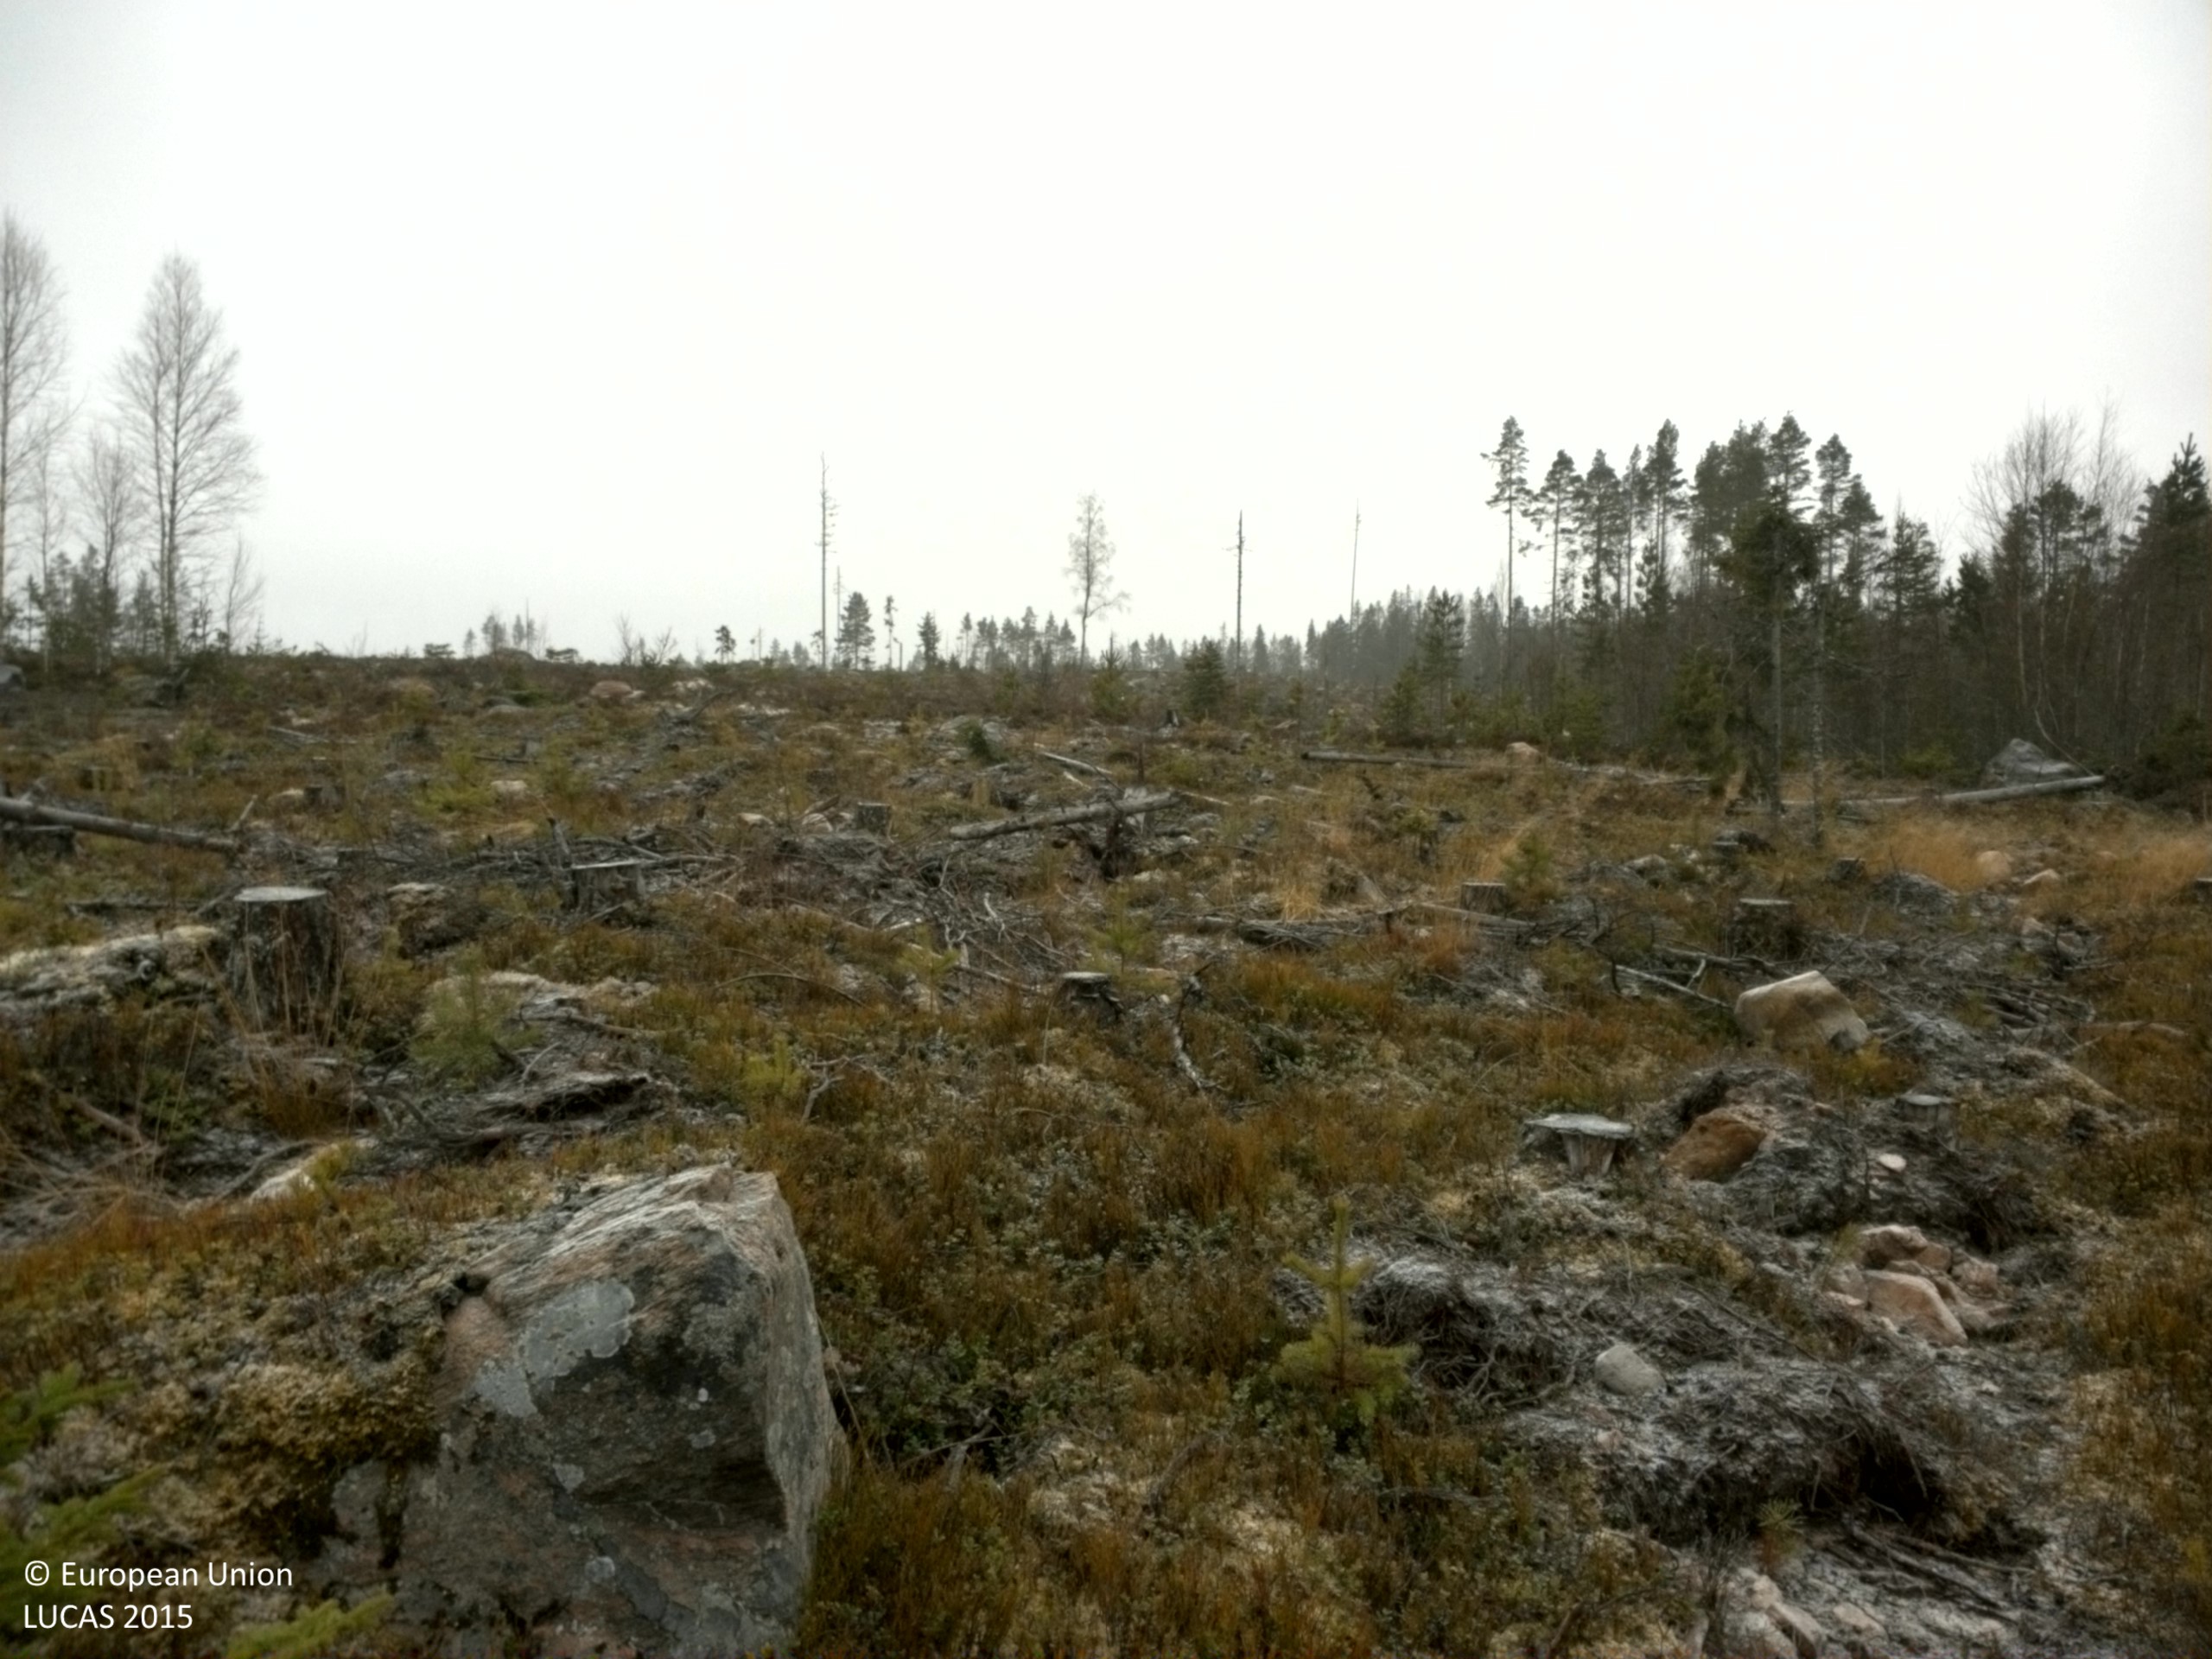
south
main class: Shrubland
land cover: Shrubland with sparse tree cover
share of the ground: 50 - 75 %
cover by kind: shrubs 40 %, herbaceous plants 30 %, lichens and mosses 20 %, coniferous forest trees 5 %, consolidated bare surface 5 %
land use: Forestry
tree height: < 5 m
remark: Clear cut
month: November
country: SE
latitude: 61.0494
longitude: 15.9305
